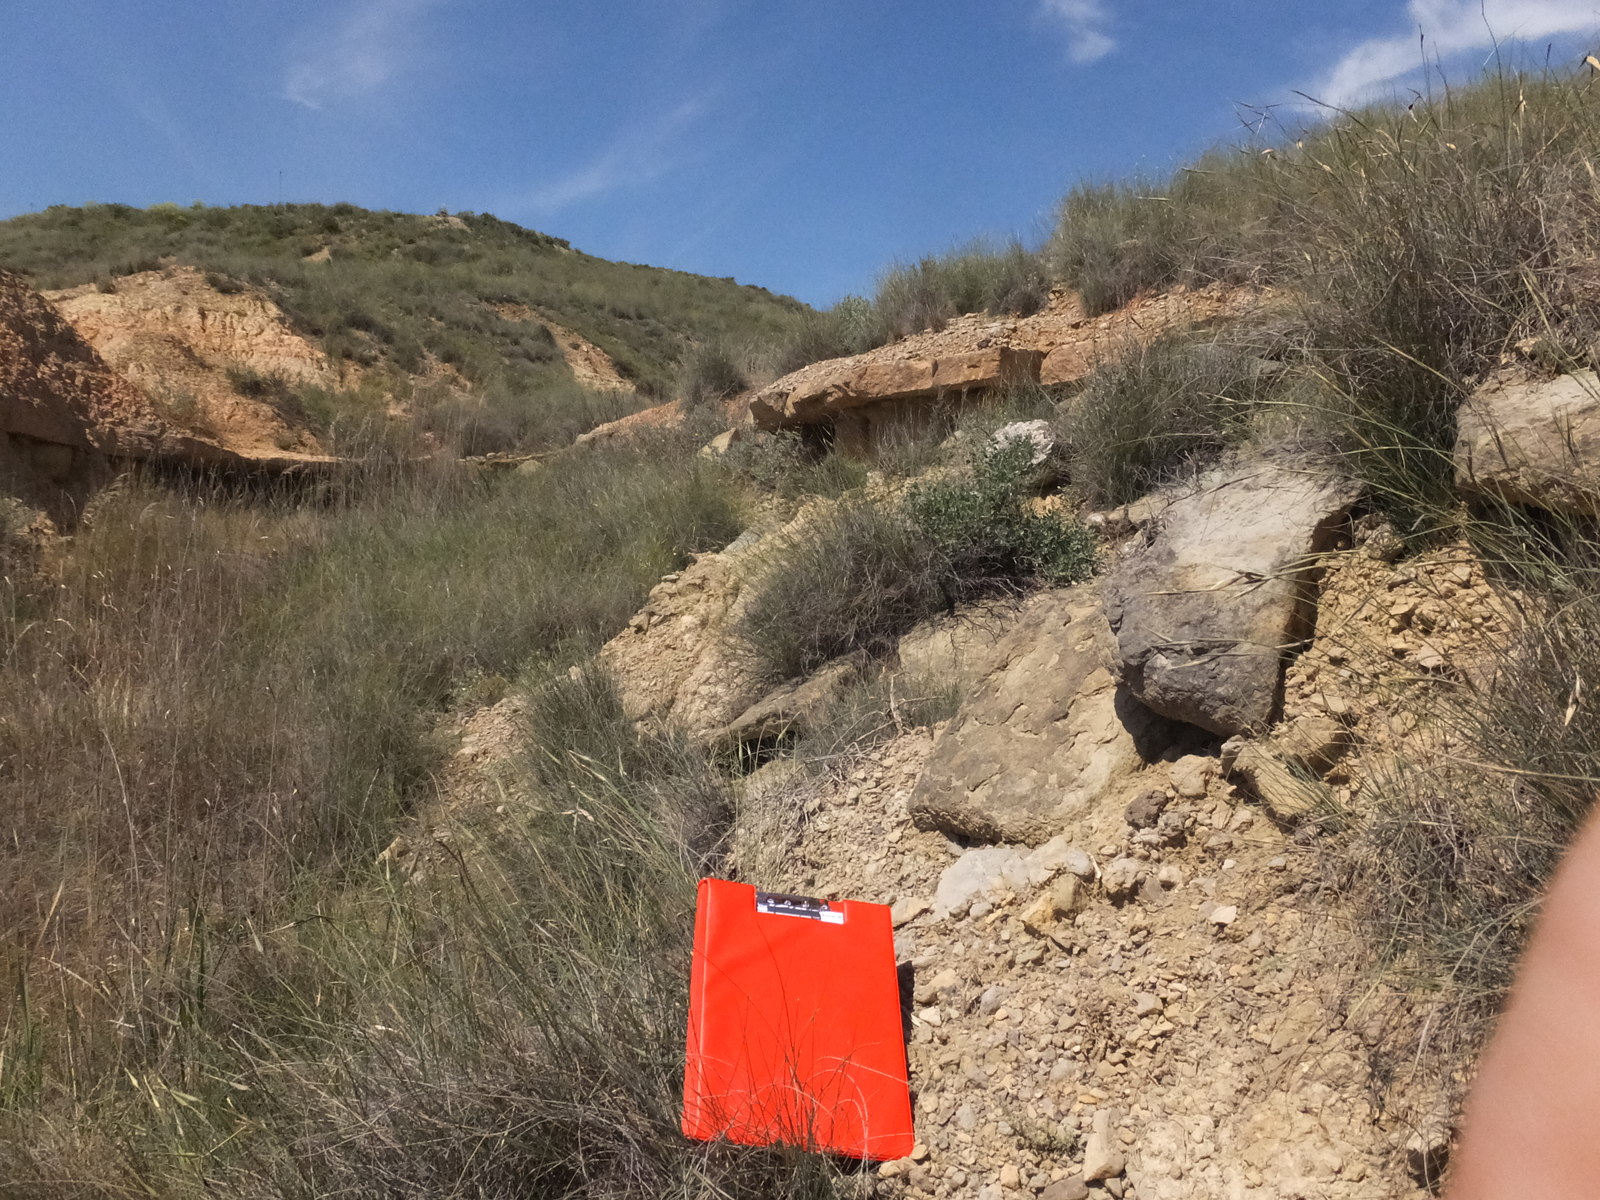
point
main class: Grassland
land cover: Grassland without tree/shrub cover
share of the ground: 50 - 75 %
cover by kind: herbaceous plants 65 %, unconsolidated bare surface 30 %, shrubs 5 %
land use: Semi-natural and natural areas not in use
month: April
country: ES
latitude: 41.7398
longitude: -0.1779
